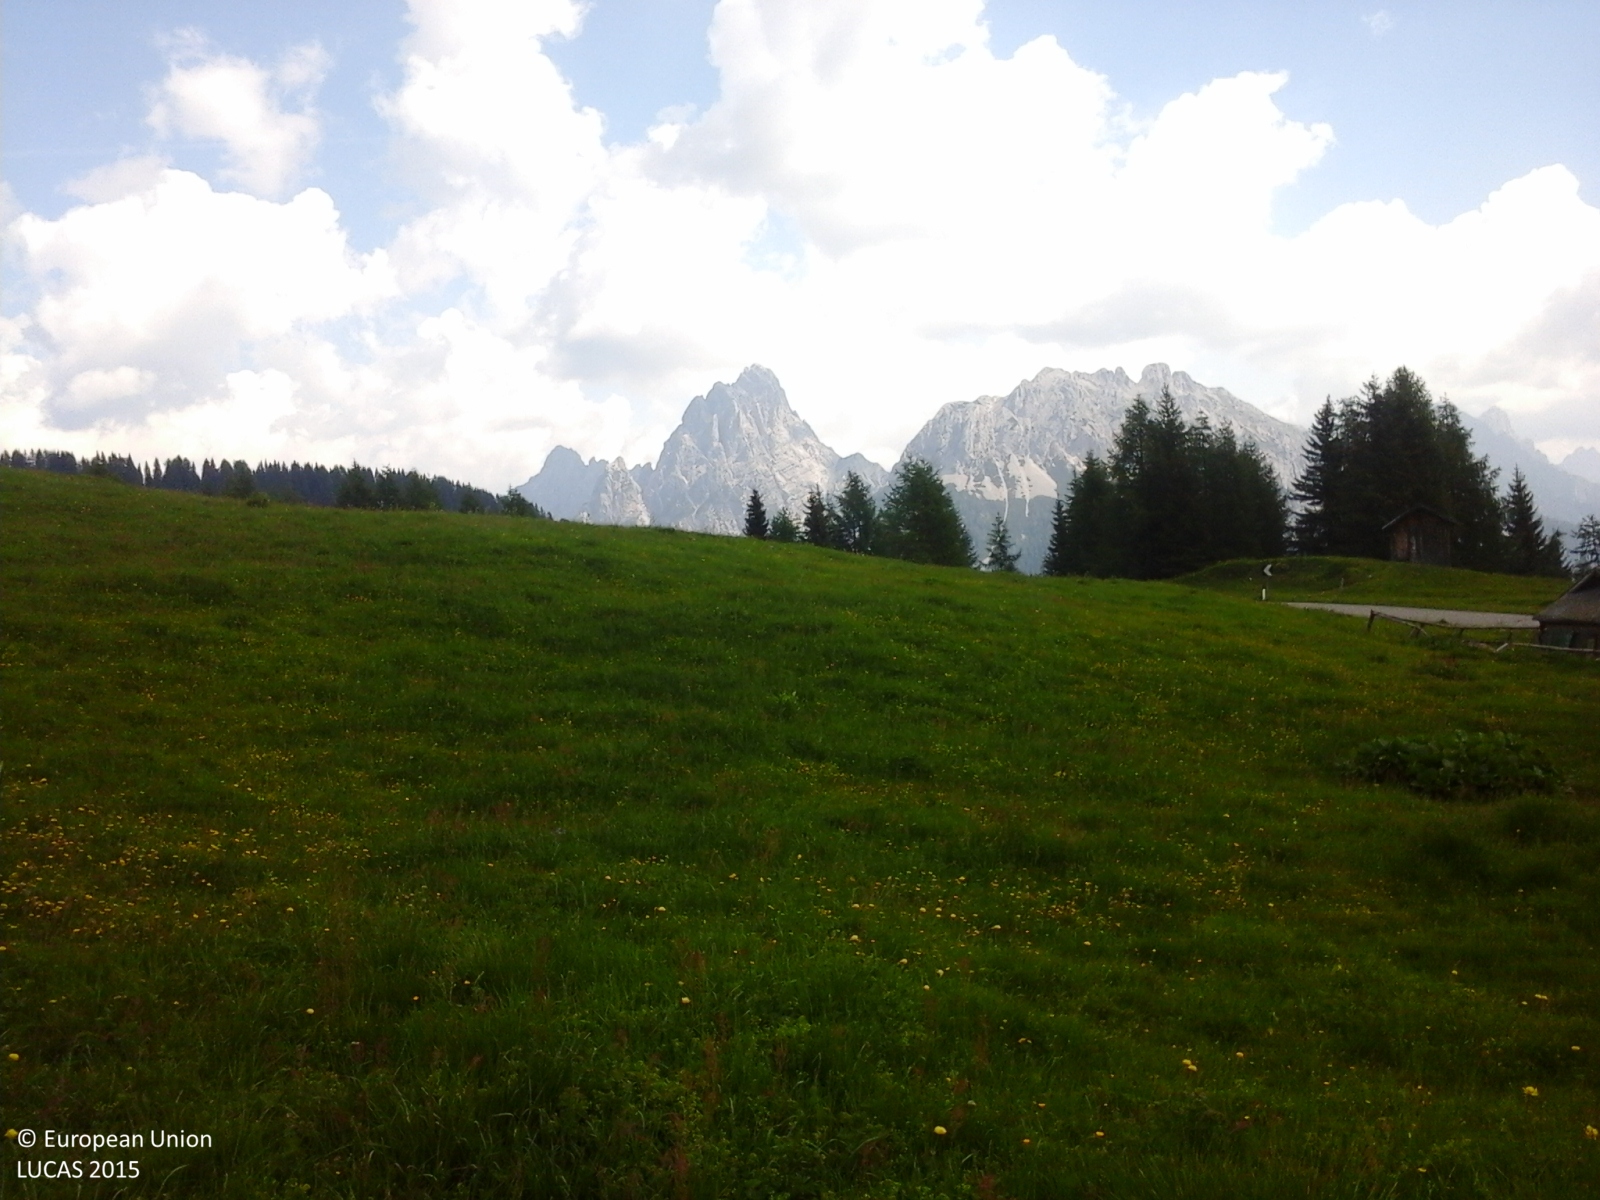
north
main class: Grassland
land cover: Grassland without tree/shrub cover
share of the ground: > 75 %
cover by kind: herbaceous plants 100 %
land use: Agriculture (excluding fallow land and kitchen gardens)
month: June
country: IT
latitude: 46.4821
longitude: 12.5894
